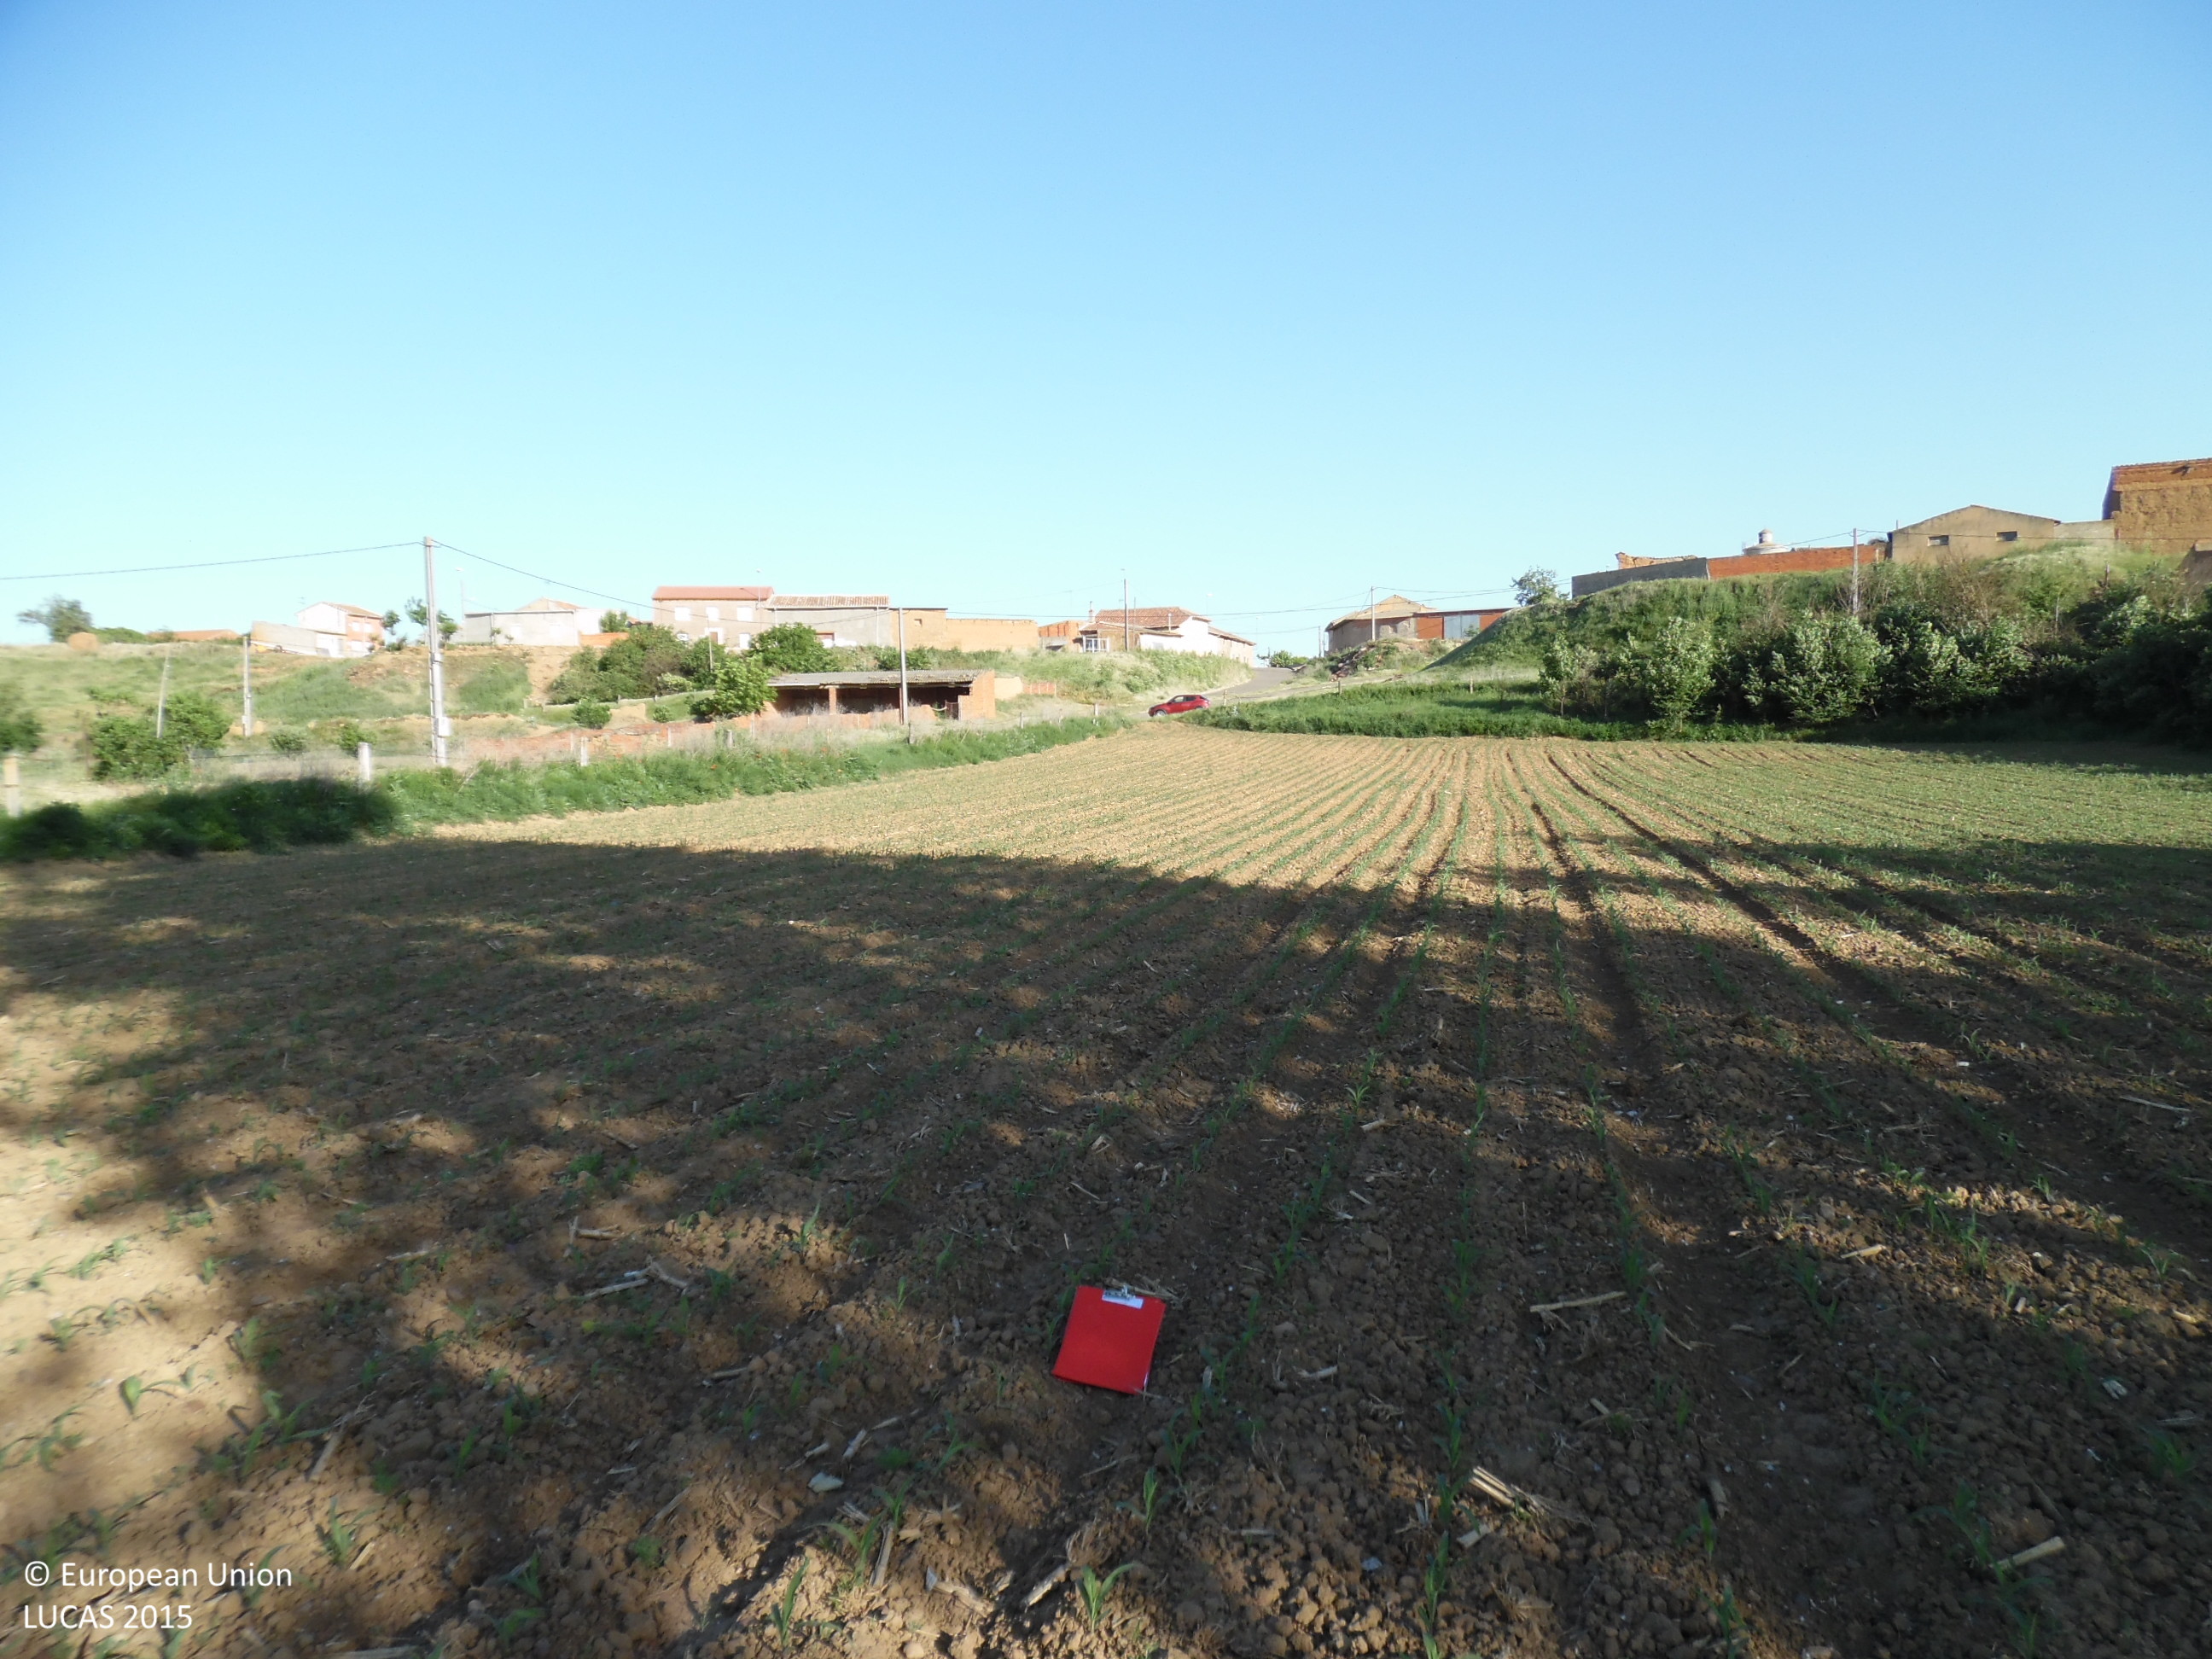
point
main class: Cropland
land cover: Maize
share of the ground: < 10 %
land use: Agriculture (excluding fallow land and kitchen gardens)
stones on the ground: < 10 %
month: May
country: ES
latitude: 42.1776
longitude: -5.6751
